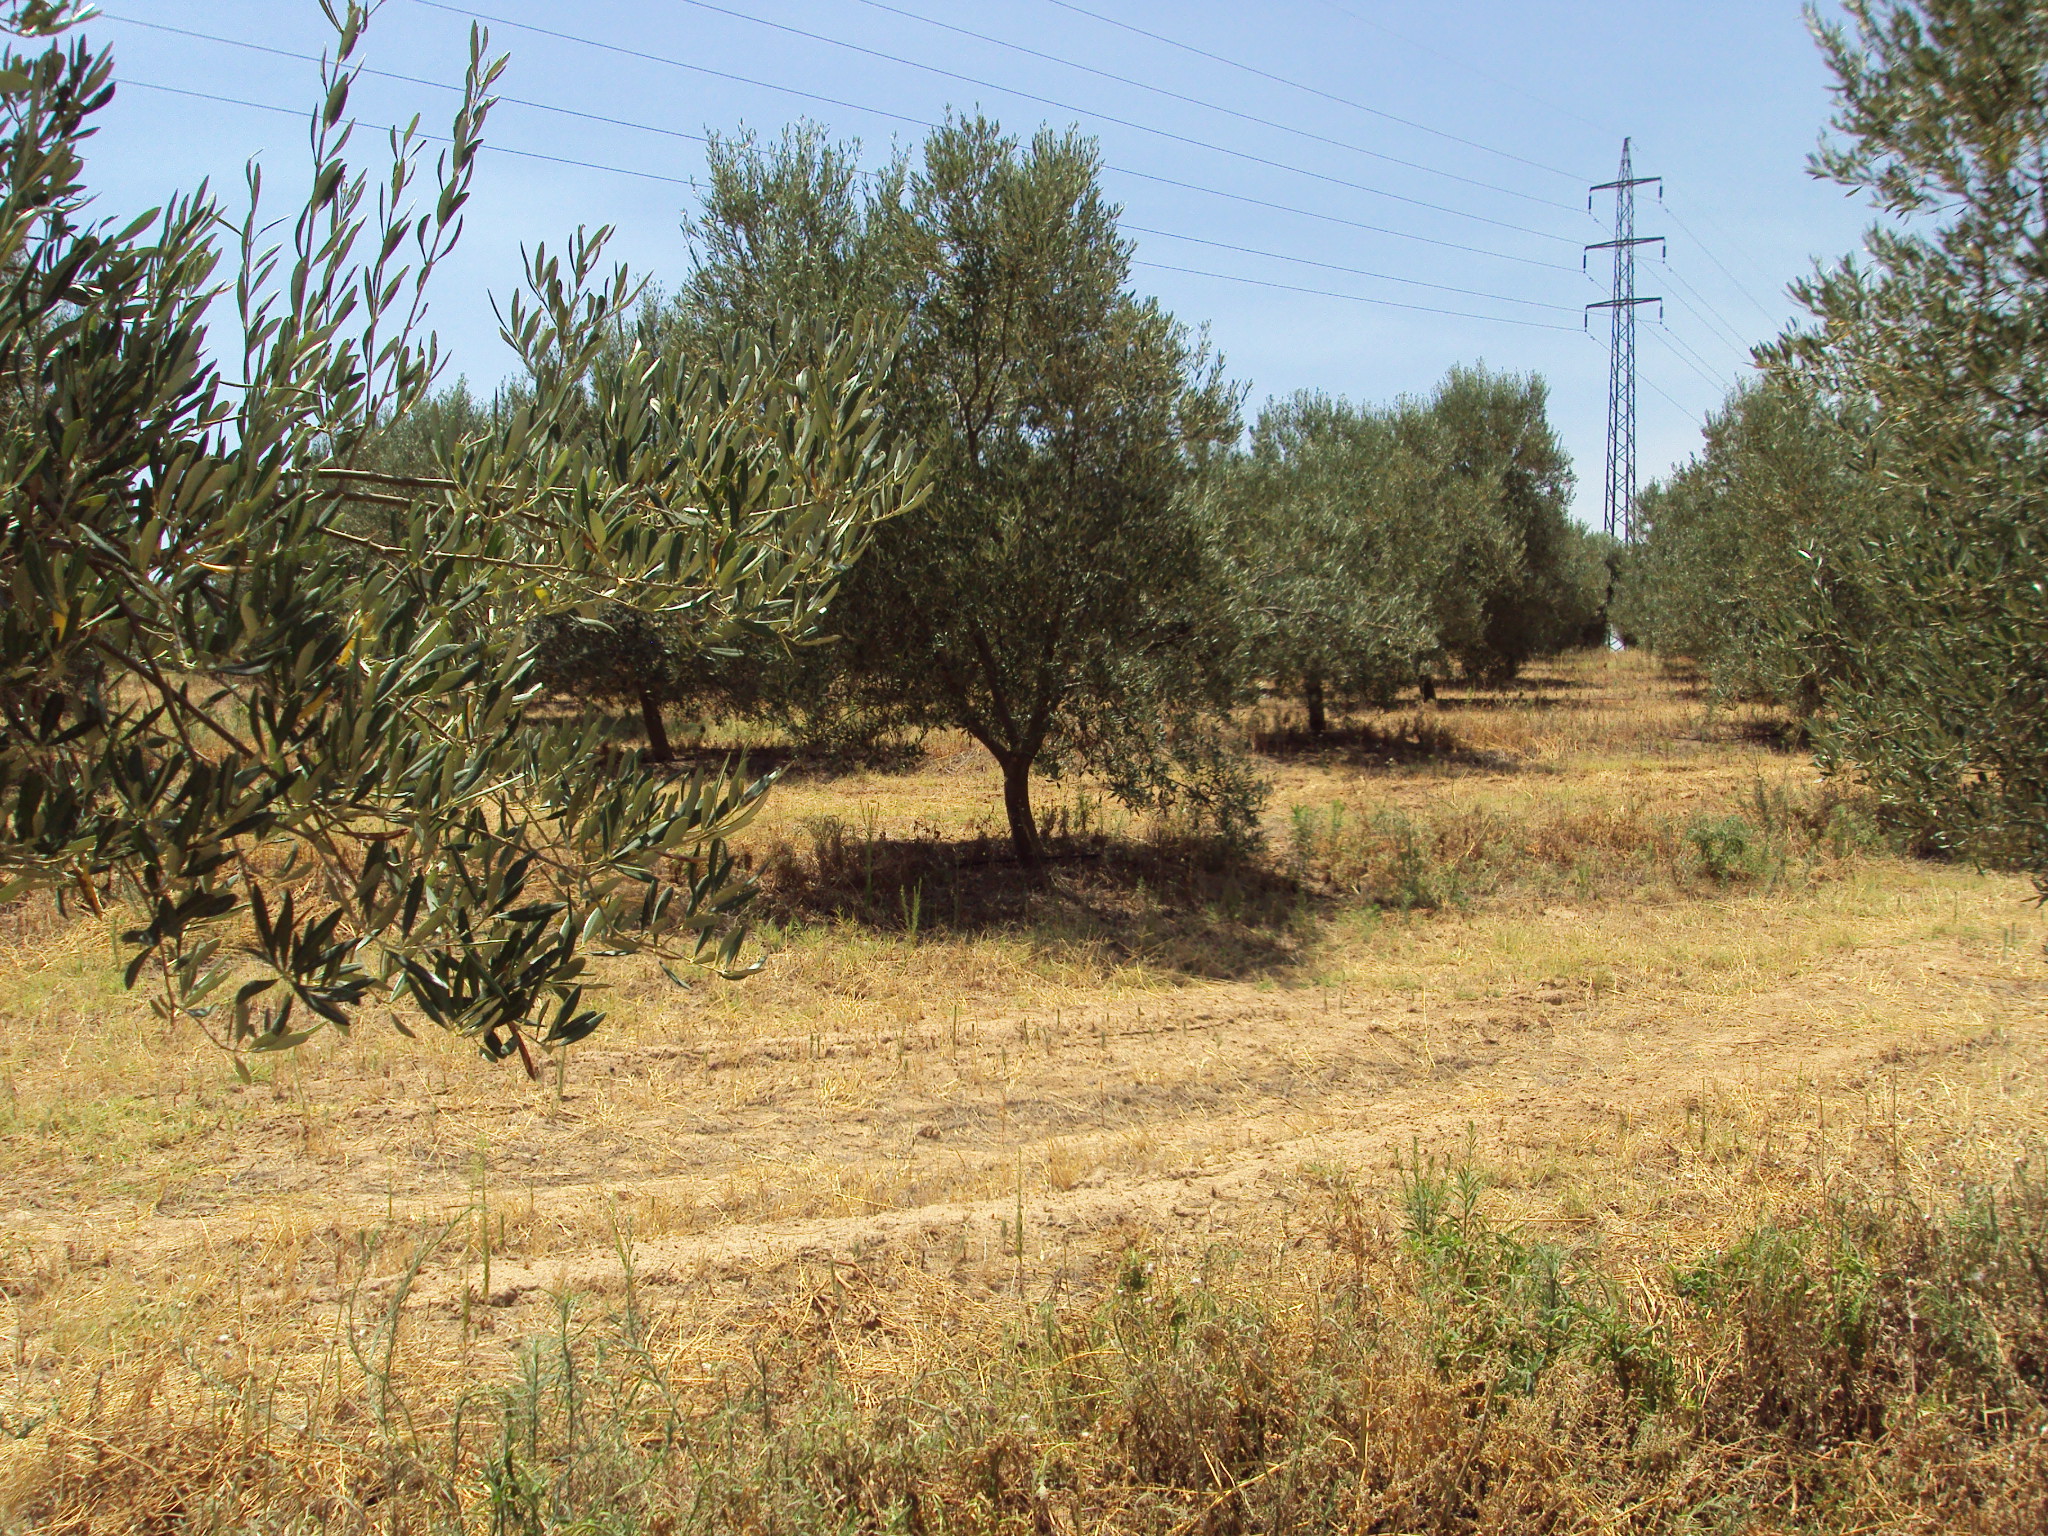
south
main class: Cropland
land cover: Olive groves
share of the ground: 50 - 75 %
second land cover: Spontaneously vegetated surfaces
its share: > 75 %
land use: Agriculture (excluding fallow land and kitchen gardens)
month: July
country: ES
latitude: 37.3447
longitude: -7.0303
